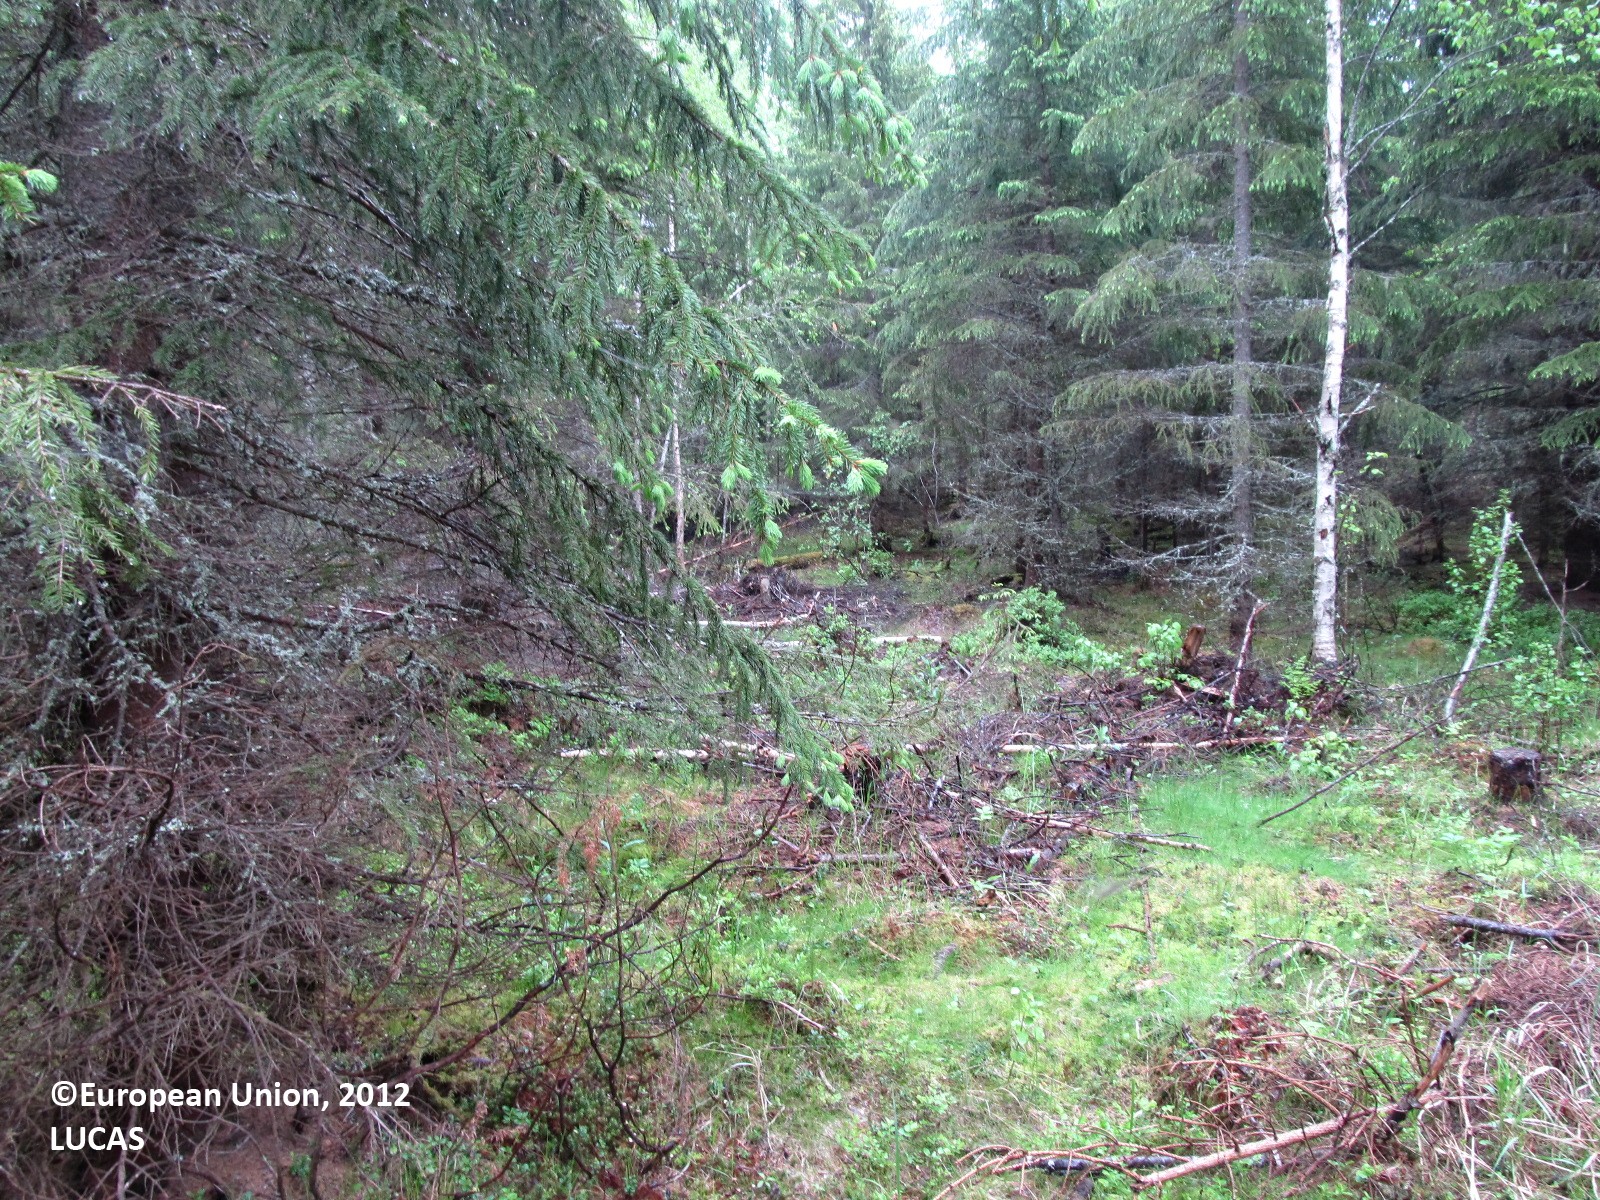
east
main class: Woodland
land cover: Spruce dominated coniferous woodland
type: boreal forest
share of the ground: 25 - 50 %
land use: Forestry
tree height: > 5 m
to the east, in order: Spruce dominated coniferous woodland; Spruce dominated mixed woodland; Spruce dominated coniferous woodland; Spruce dominated mixed woodland; Spruce dominated coniferous woodland; Broadleaved woodland; Pine dominated mixed woodland; Grassland with sparse tree/shrub cover; Other bare soil; Grassland with sparse tree/shrub cover
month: June
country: FI
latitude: 62.8437
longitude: 28.5210
